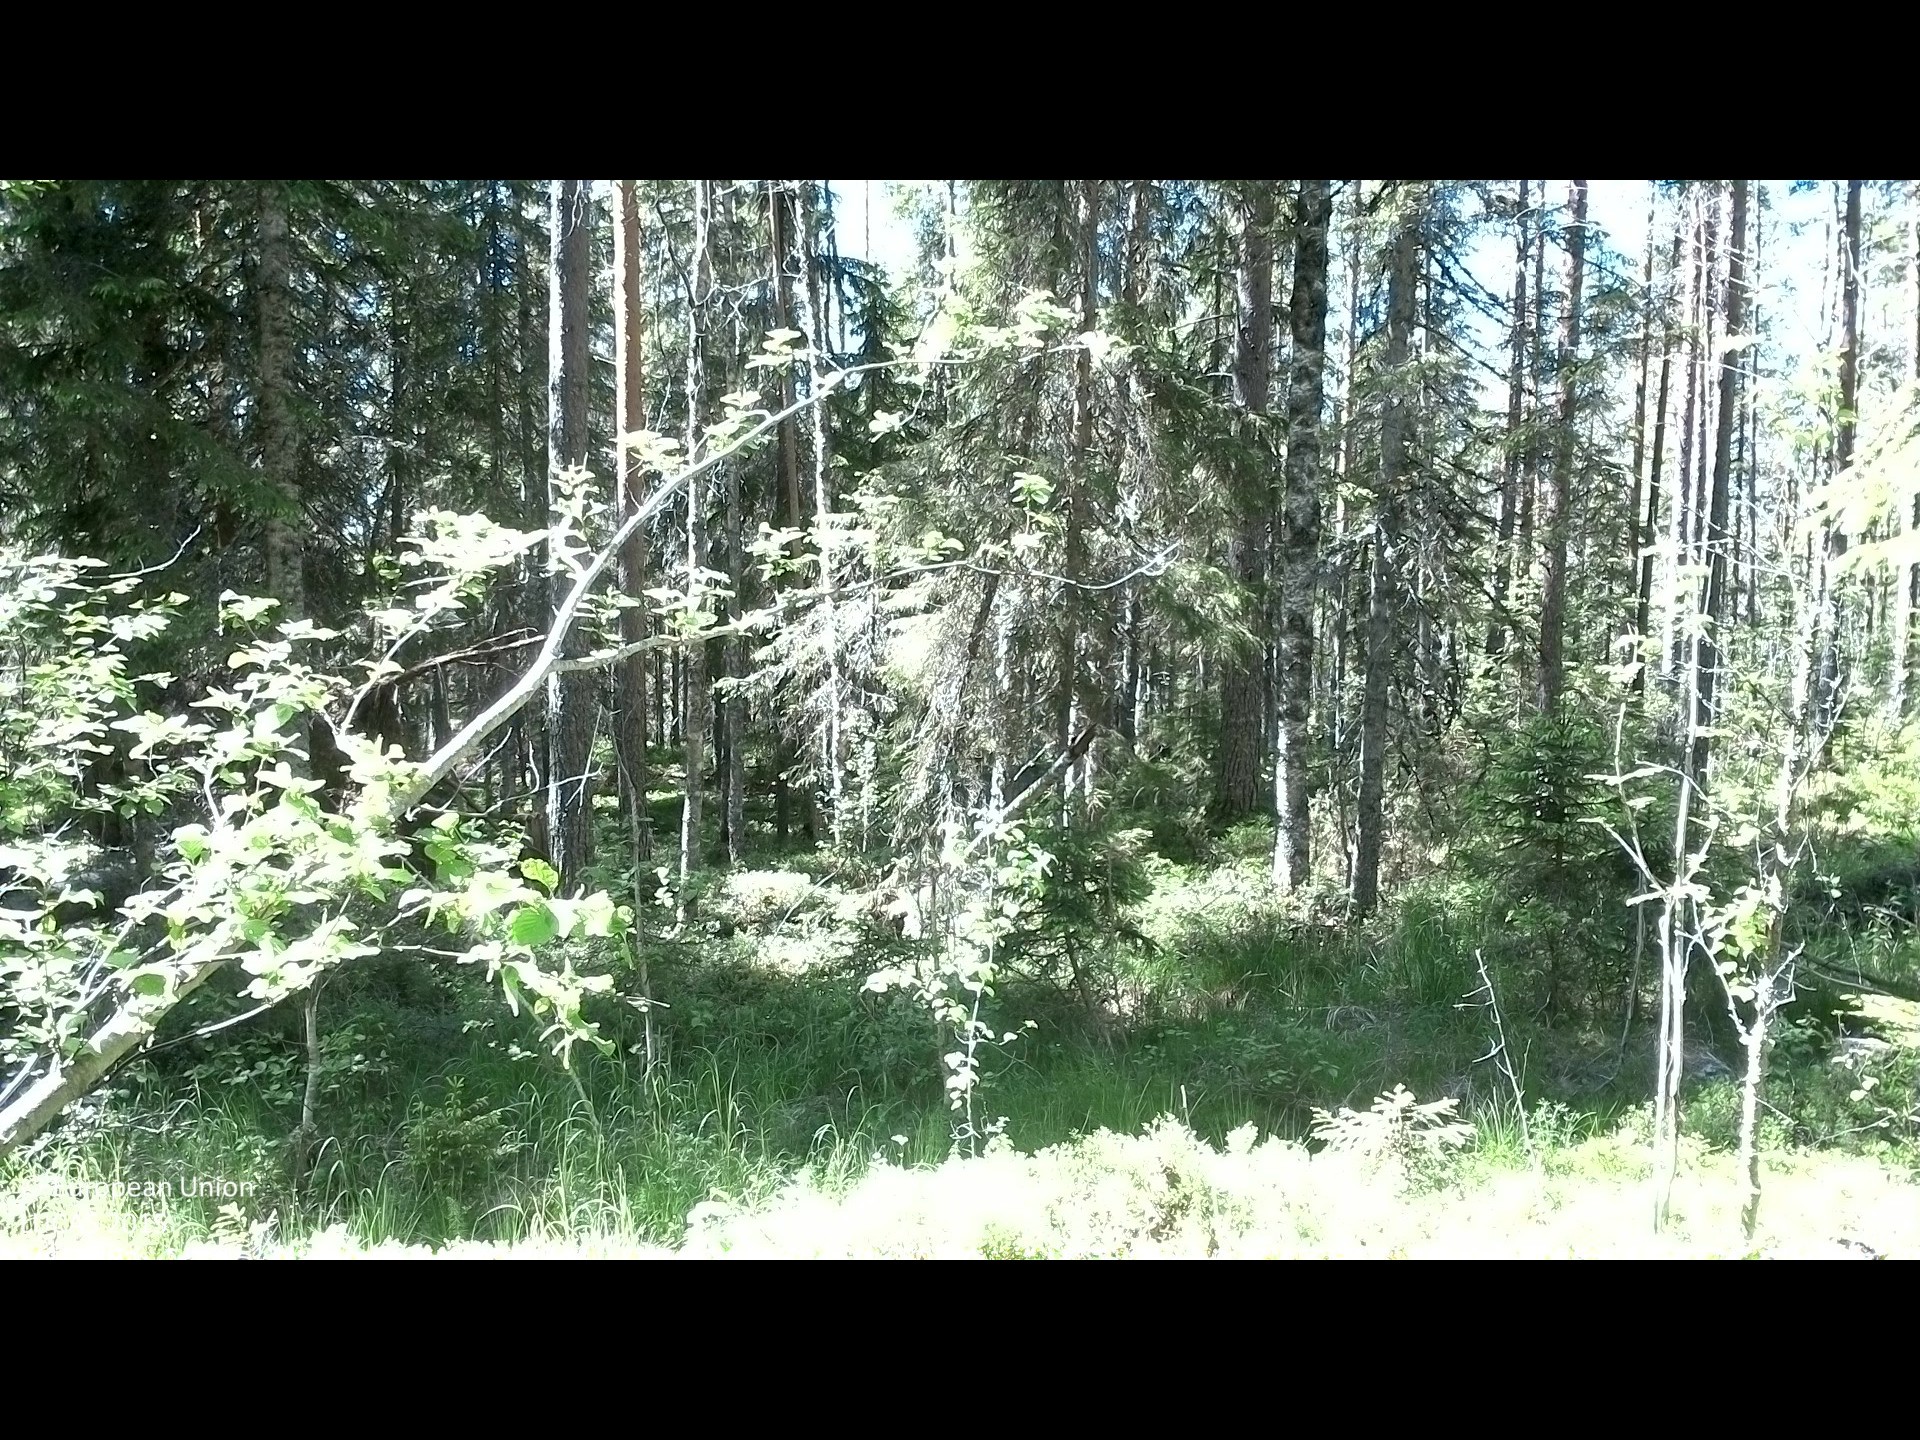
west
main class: Woodland
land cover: Pine dominated coniferous woodland
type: boreal forest
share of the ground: 25 - 50 %
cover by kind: coniferous forest trees 45 %, shrubs 40 %, lichens and mosses 10 %, broadleaved forest trees 5 %
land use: Forestry
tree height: > 5 m
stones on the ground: 10 - 25 %
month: June
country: SE
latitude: 62.0523
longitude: 16.1592
